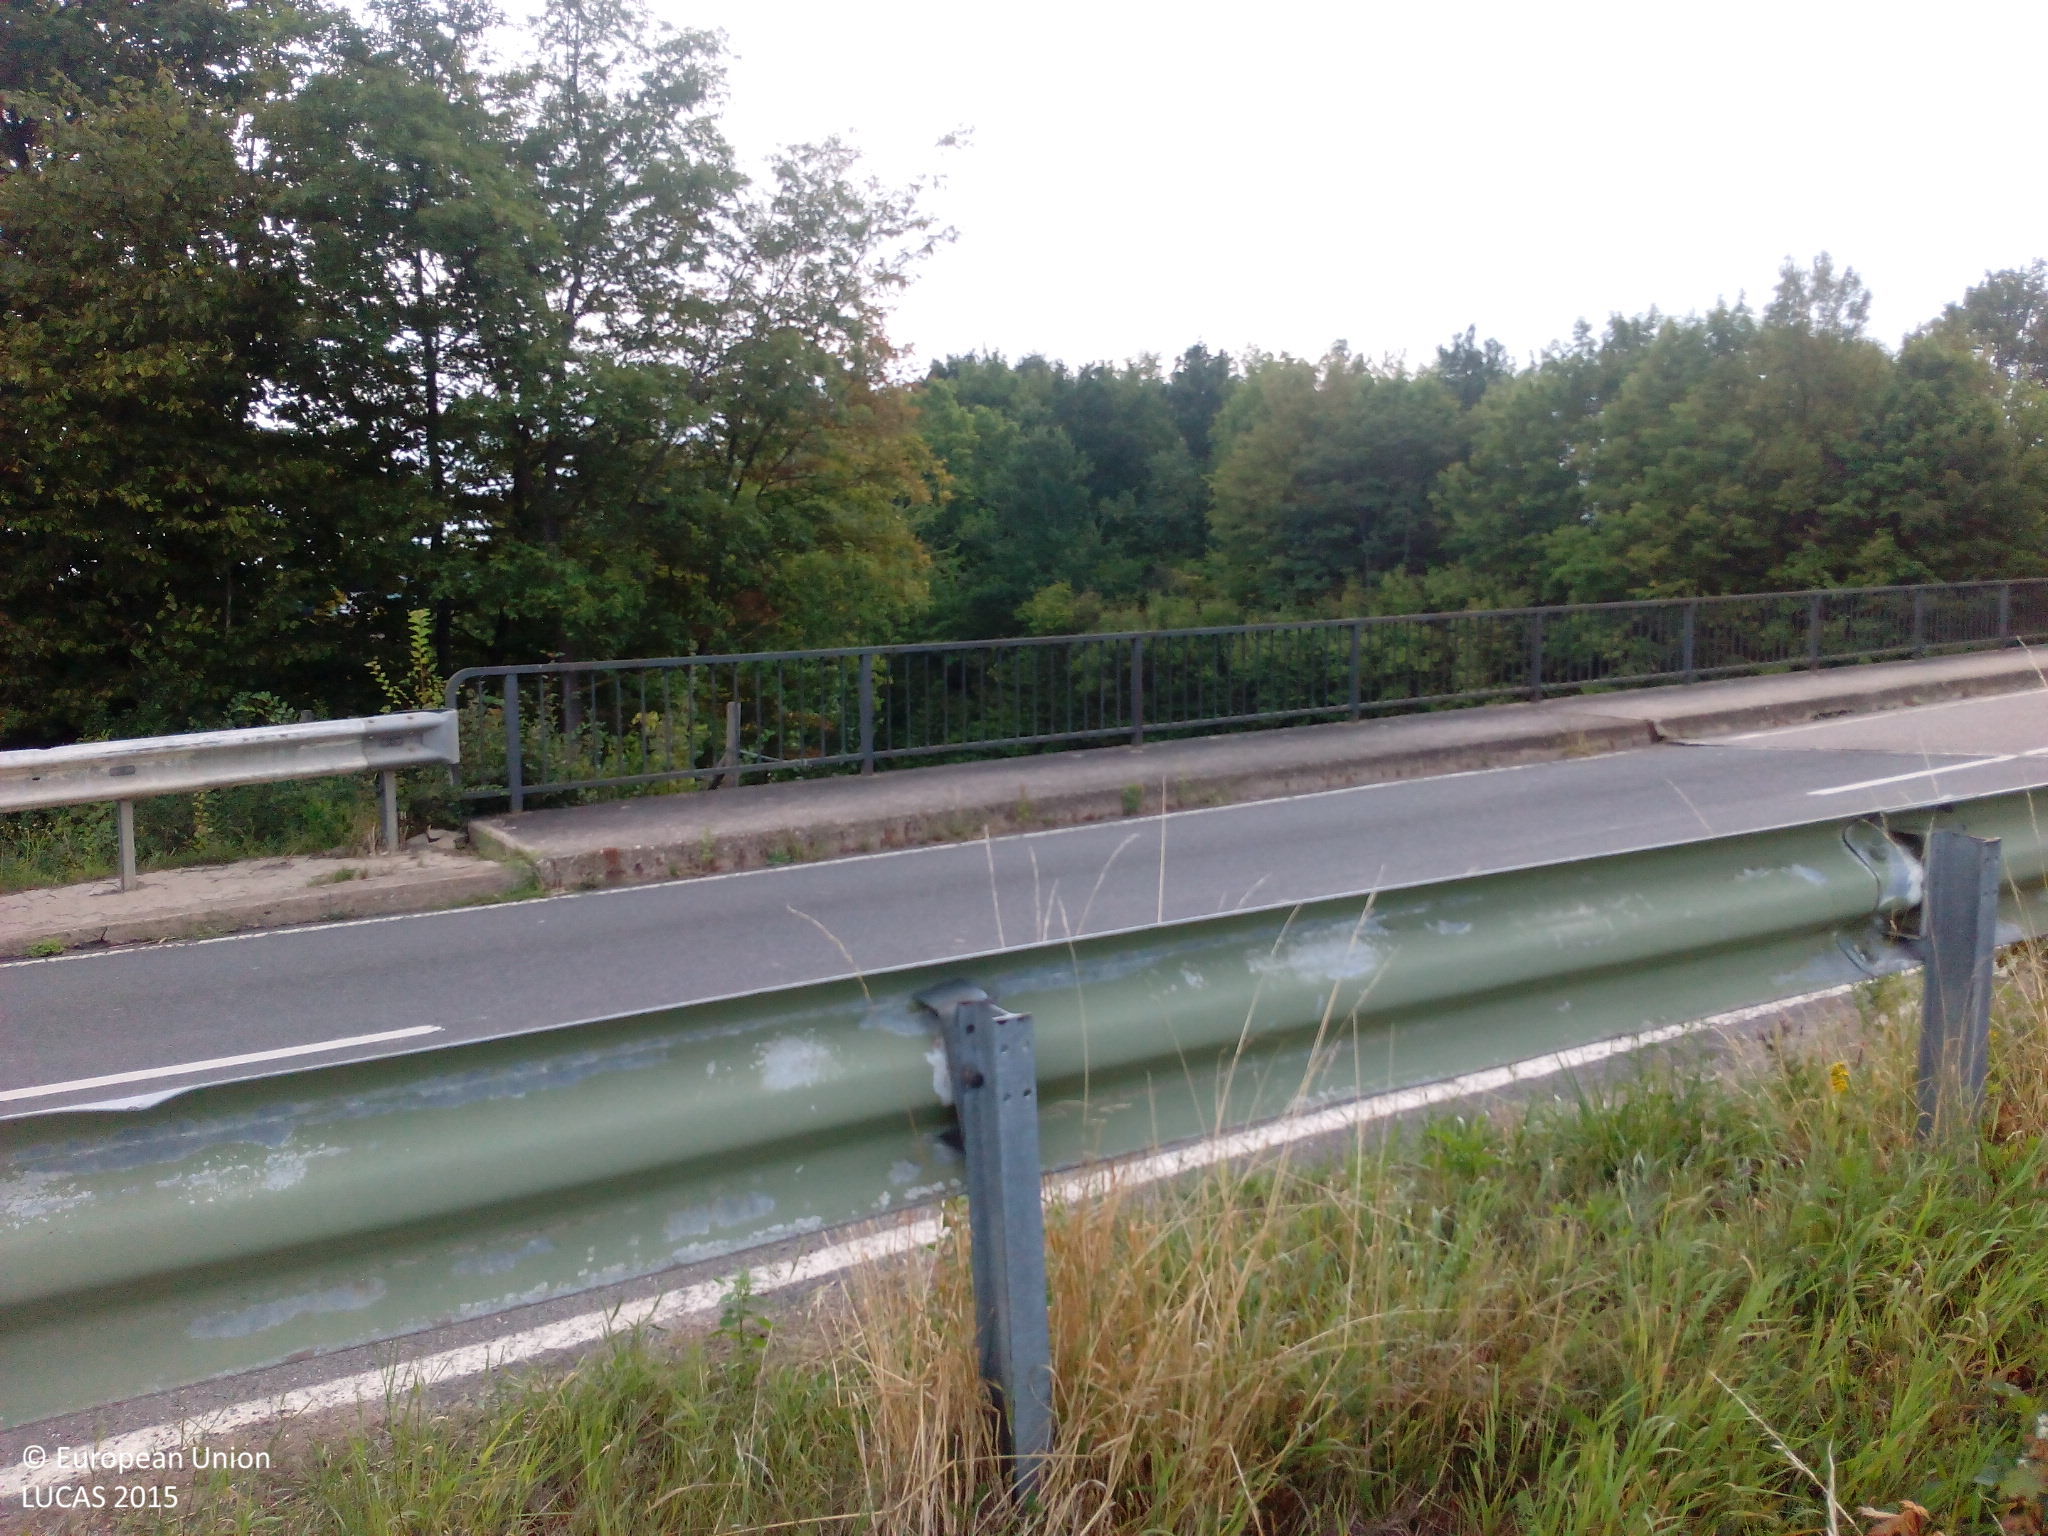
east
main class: Grassland
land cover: Grassland without tree/shrub cover
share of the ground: > 75 %
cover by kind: herbaceous plants 95 %, unconsolidated bare surface 5 %
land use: Road transport
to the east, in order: Grassland without tree/shrub cover; Paved roads, cycling and walking lanes; Broadleaved woodland; Ditches and canals; Grass margins; Paved roads, cycling and walking lanes; Grassland without tree/shrub cover; Paved roads, cycling and walking lanes; Ditches and canals; Grass margins; Broadleaved woodland; Paved roads, cycling and walking lanes; Grass margins; Fences; Grass margins; Paved roads, cycling and walking lanes; Other bare soil; Electric lines; Other bare soil
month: August
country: DE
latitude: 50.3005
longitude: 7.4873
